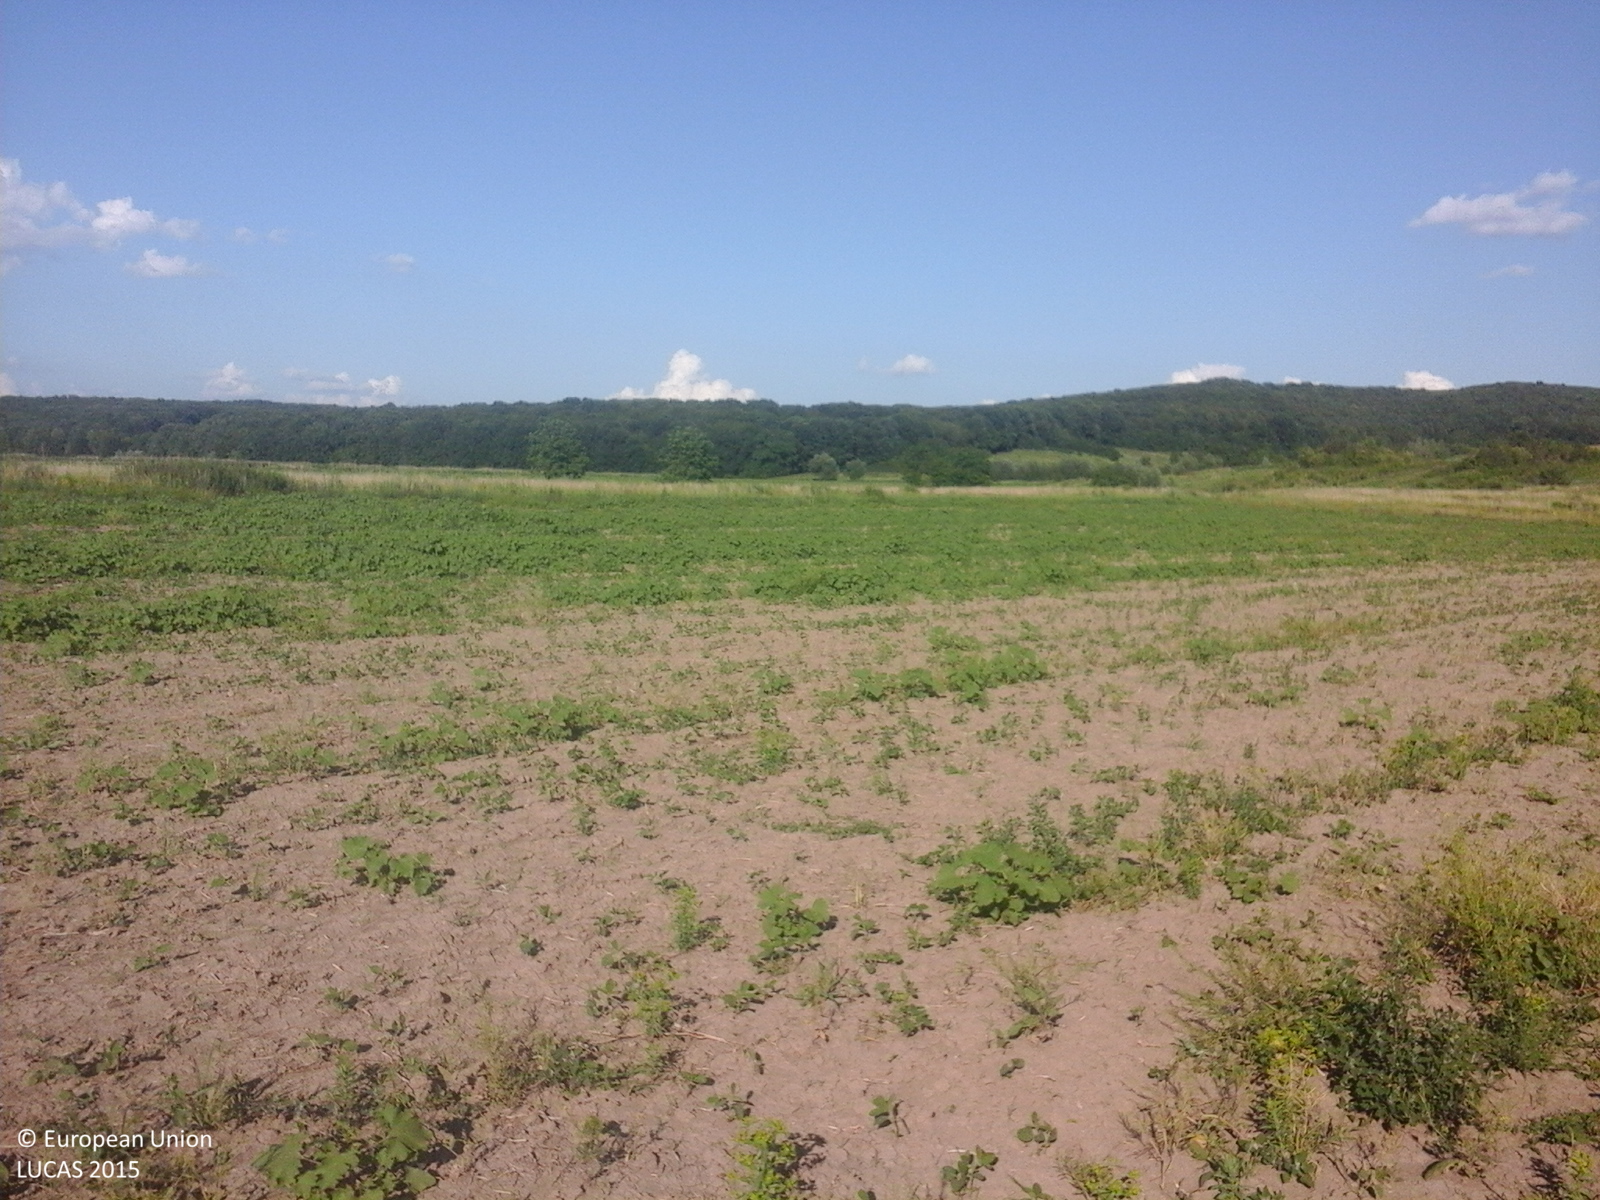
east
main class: Cropland
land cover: Soya
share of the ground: 10 - 25 %
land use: Agriculture (excluding fallow land and kitchen gardens)
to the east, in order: Soya; Grassland without tree/shrub cover; Soya
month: June
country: RO
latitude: 48.2364
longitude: 26.6171
